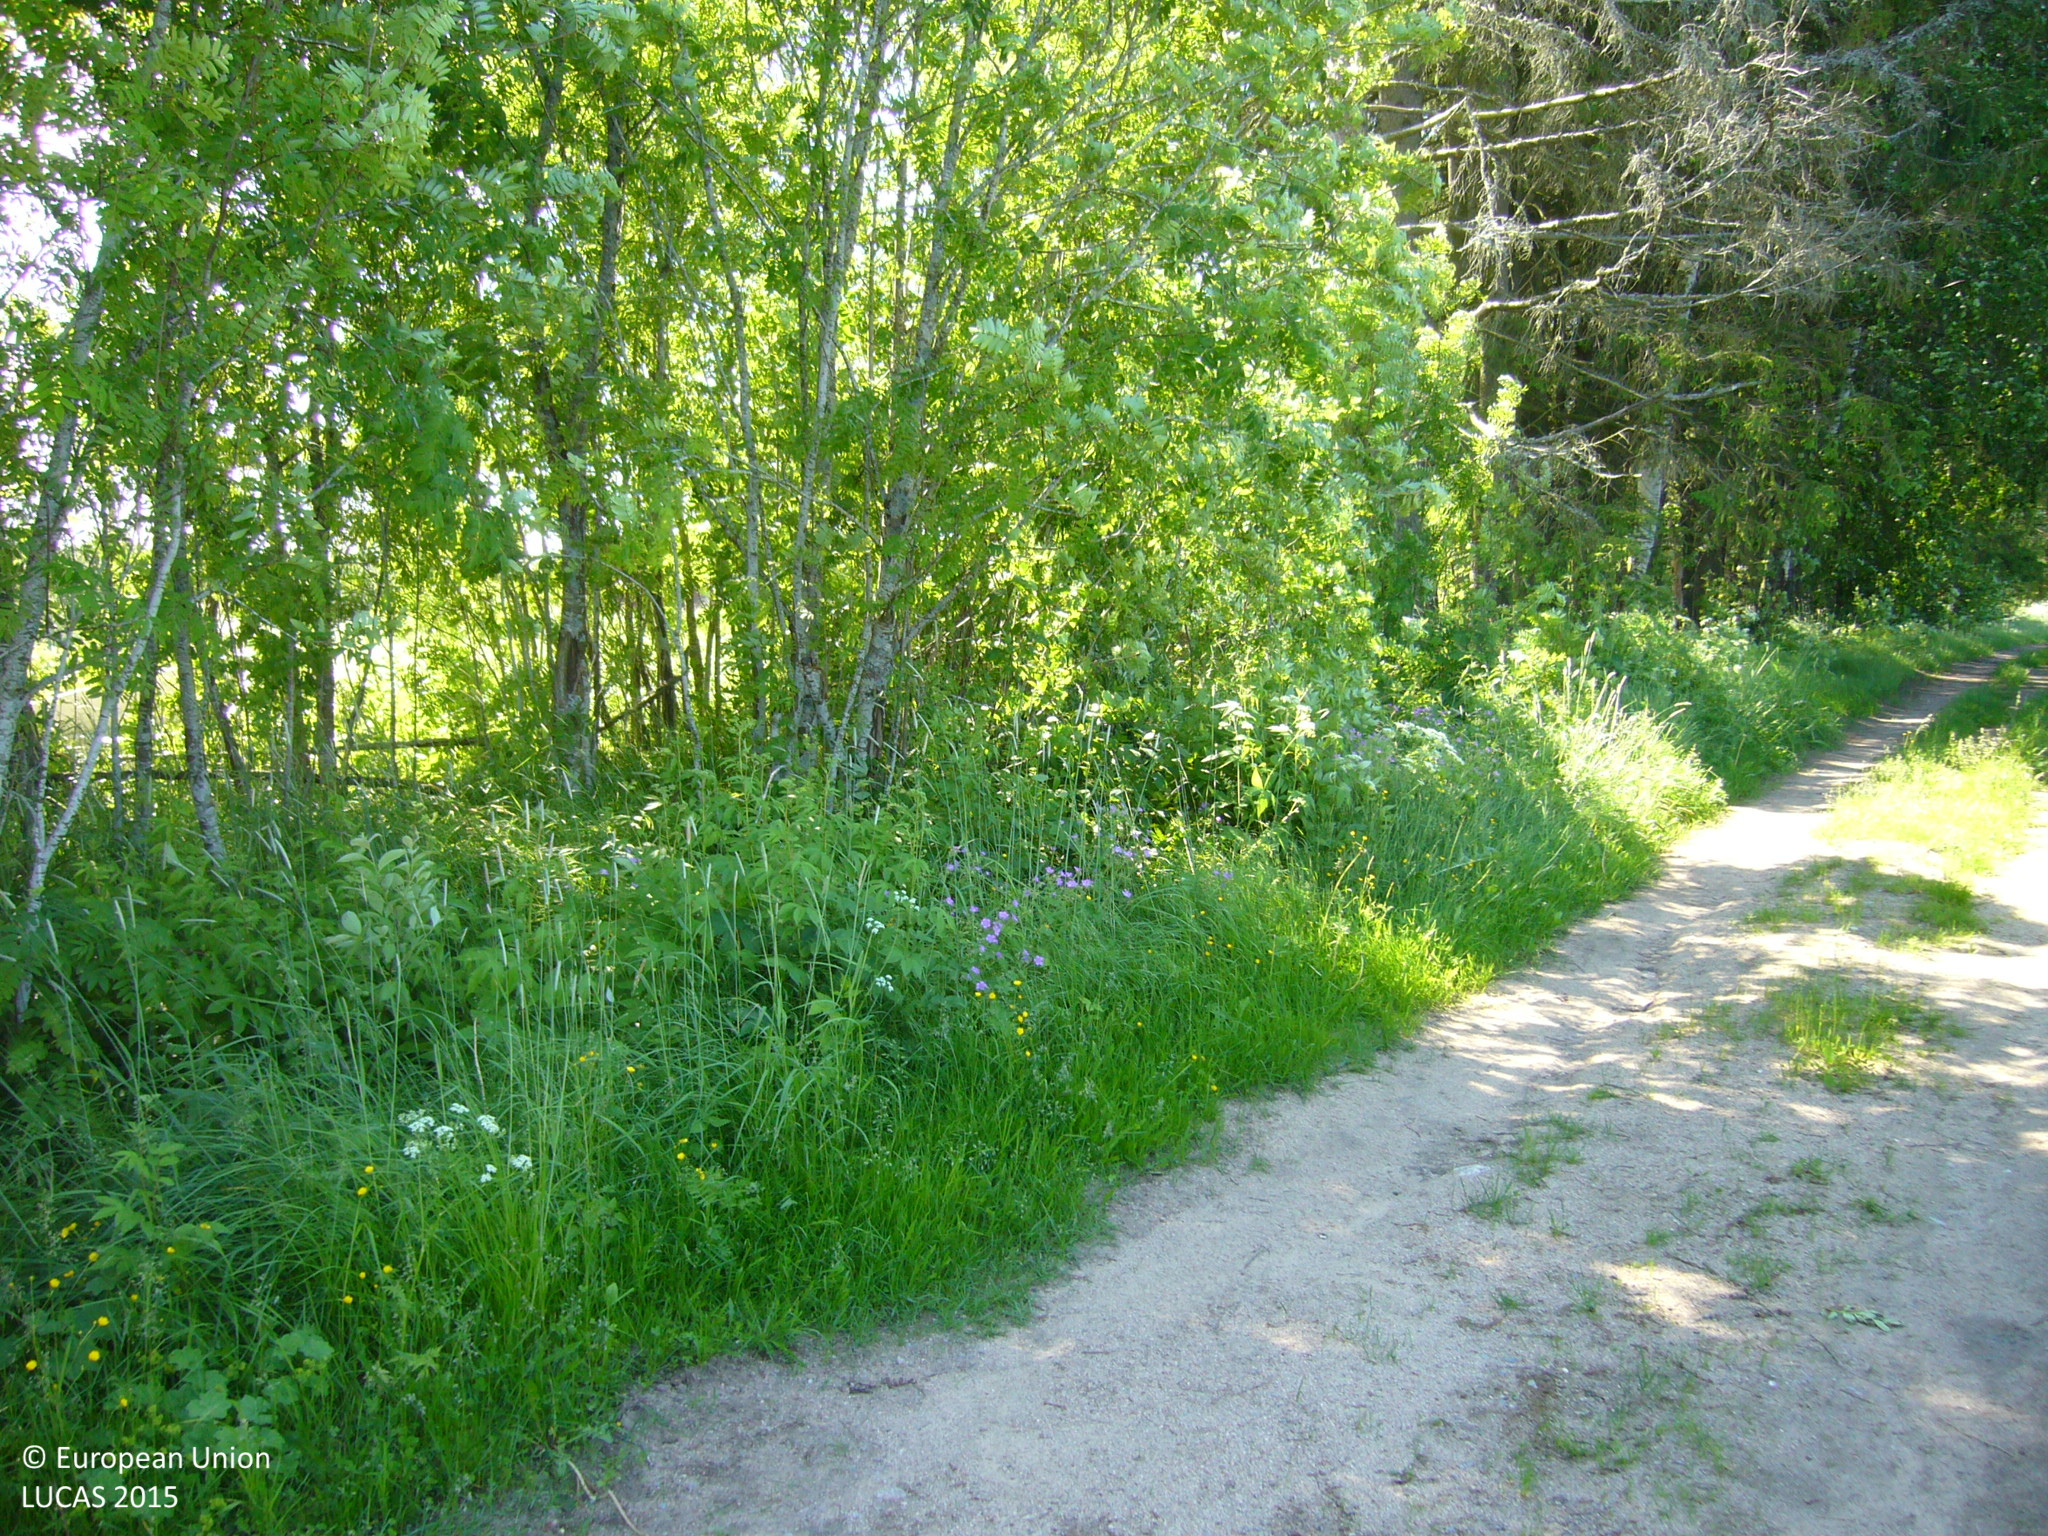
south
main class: Grassland
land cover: Grassland without tree/shrub cover
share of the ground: > 75 %
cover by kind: herbaceous plants 100 %
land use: Agriculture (excluding fallow land and kitchen gardens)
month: July
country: FI
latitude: 63.3310
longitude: 26.2373
